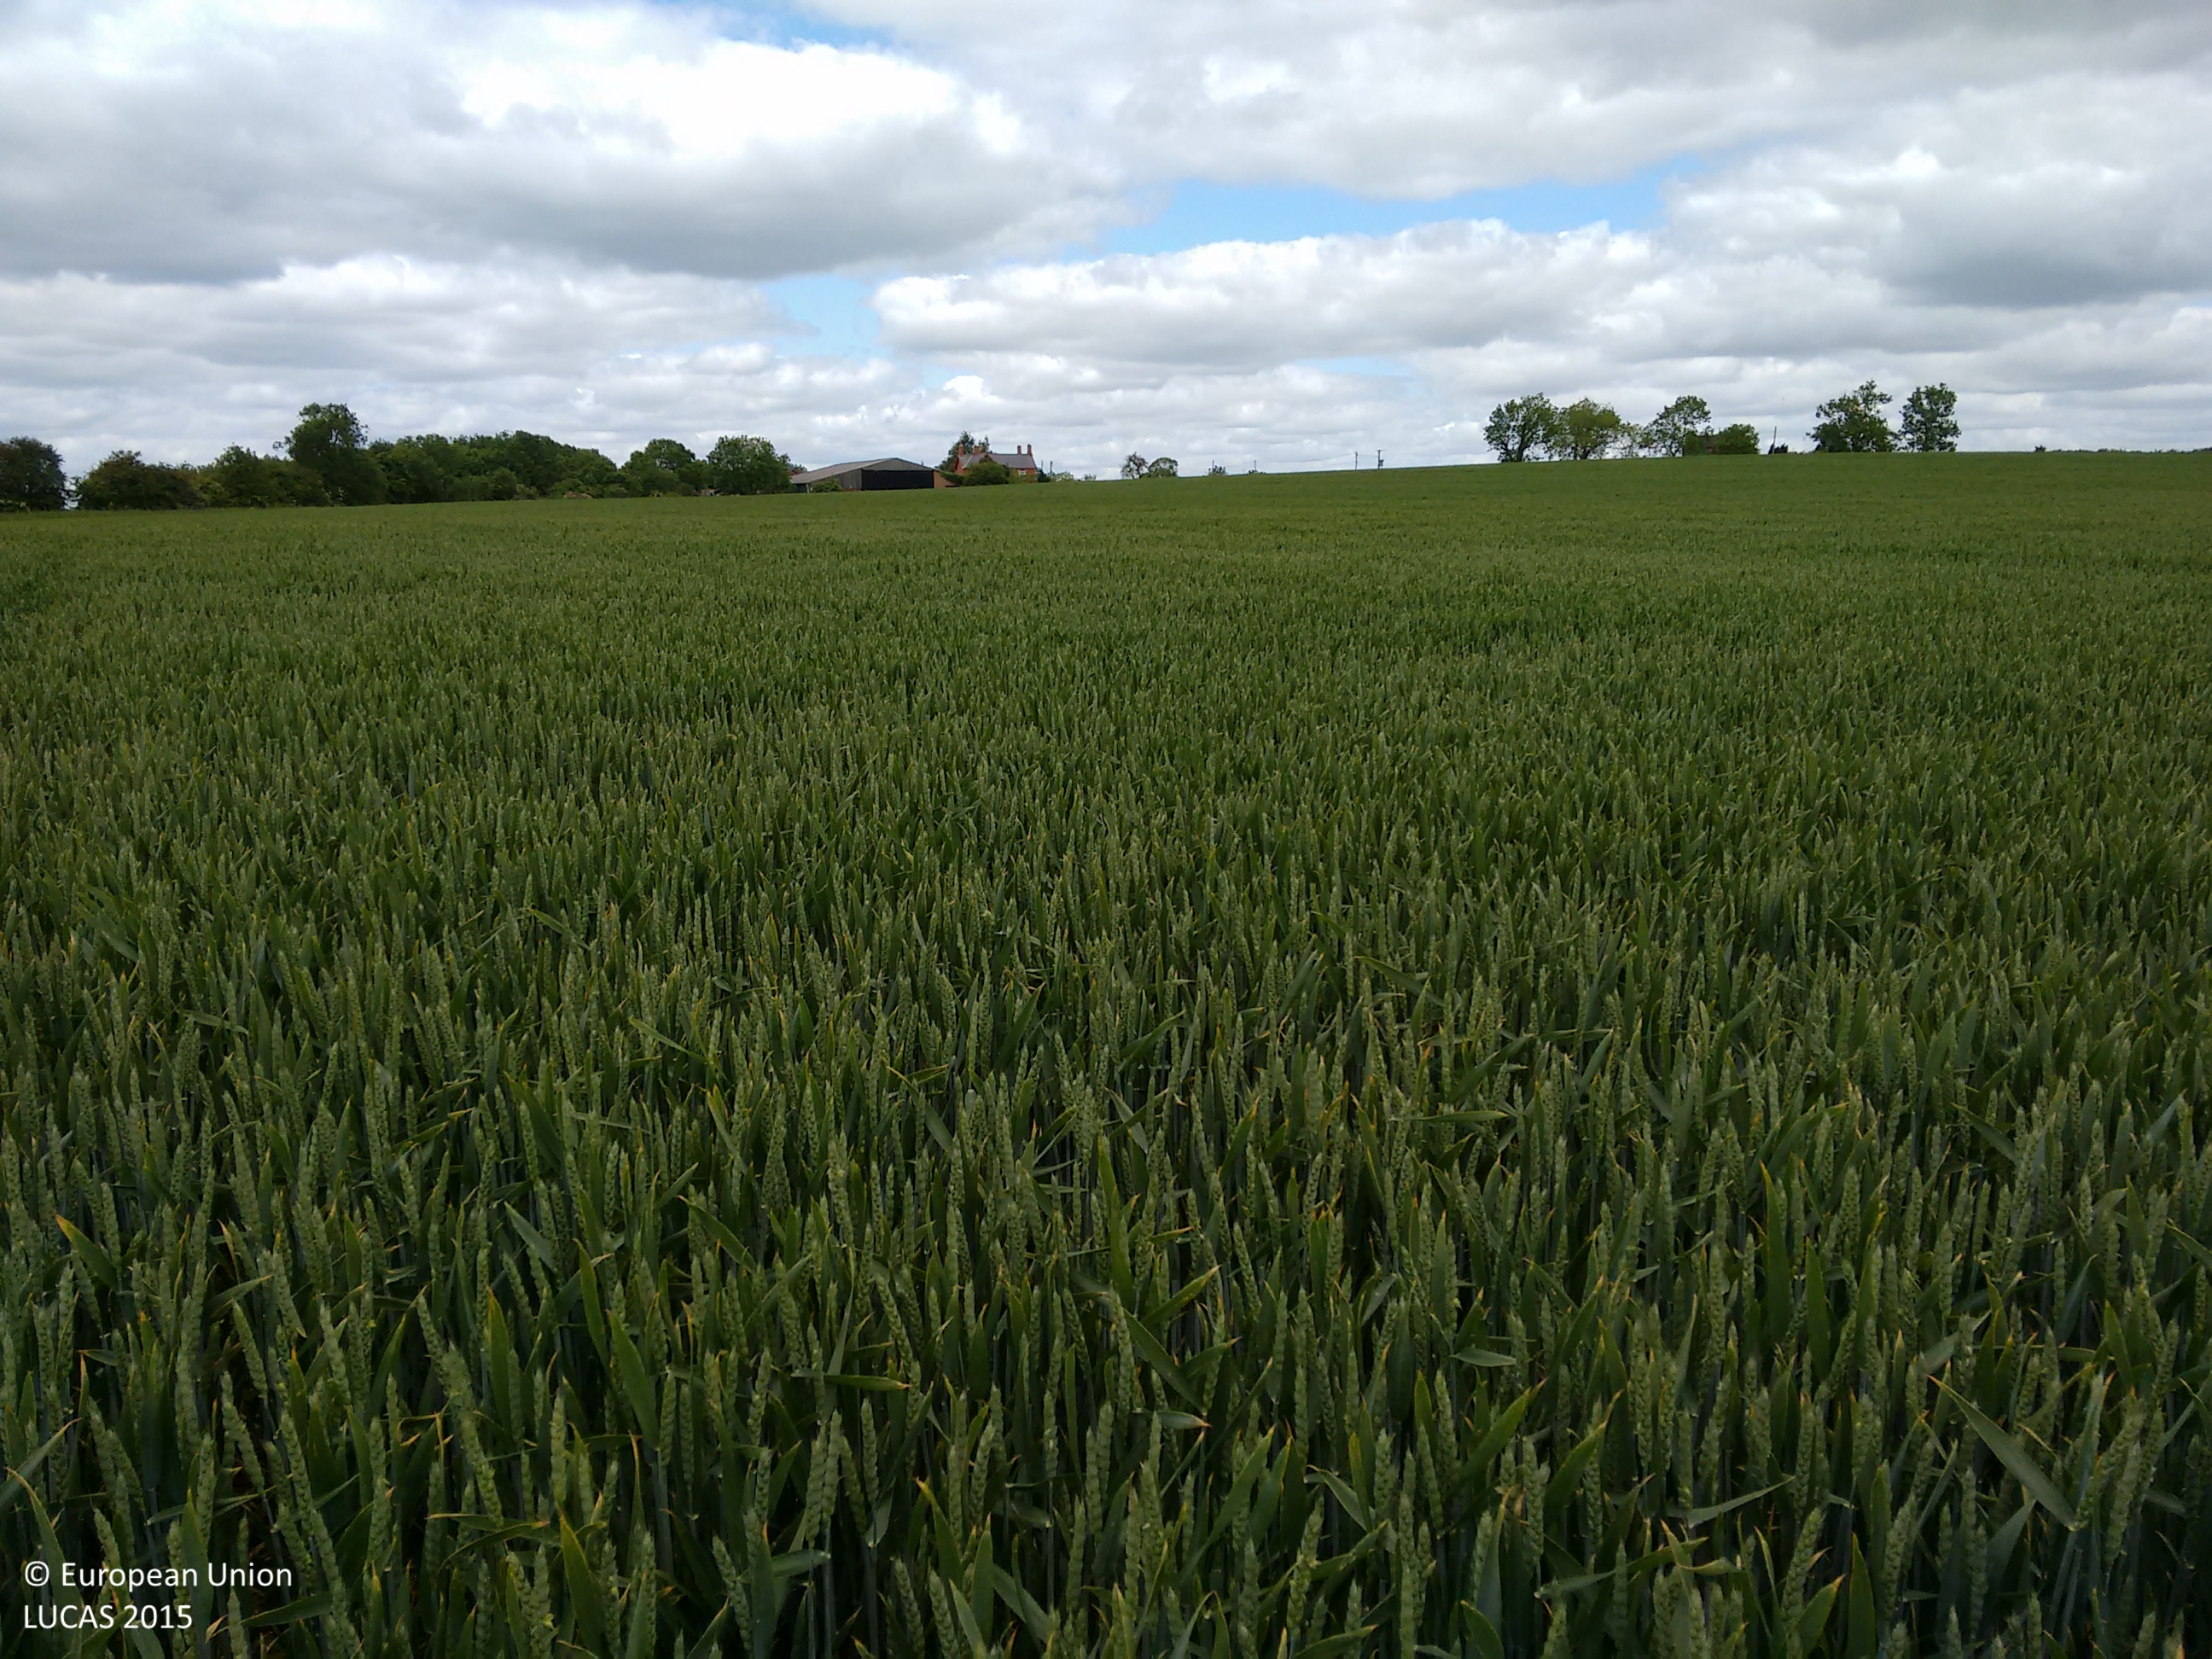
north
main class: Cropland
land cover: Common wheat
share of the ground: > 75 %
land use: Agriculture (excluding fallow land and kitchen gardens)
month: June
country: GB
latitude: 52.8732
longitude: -0.4821
